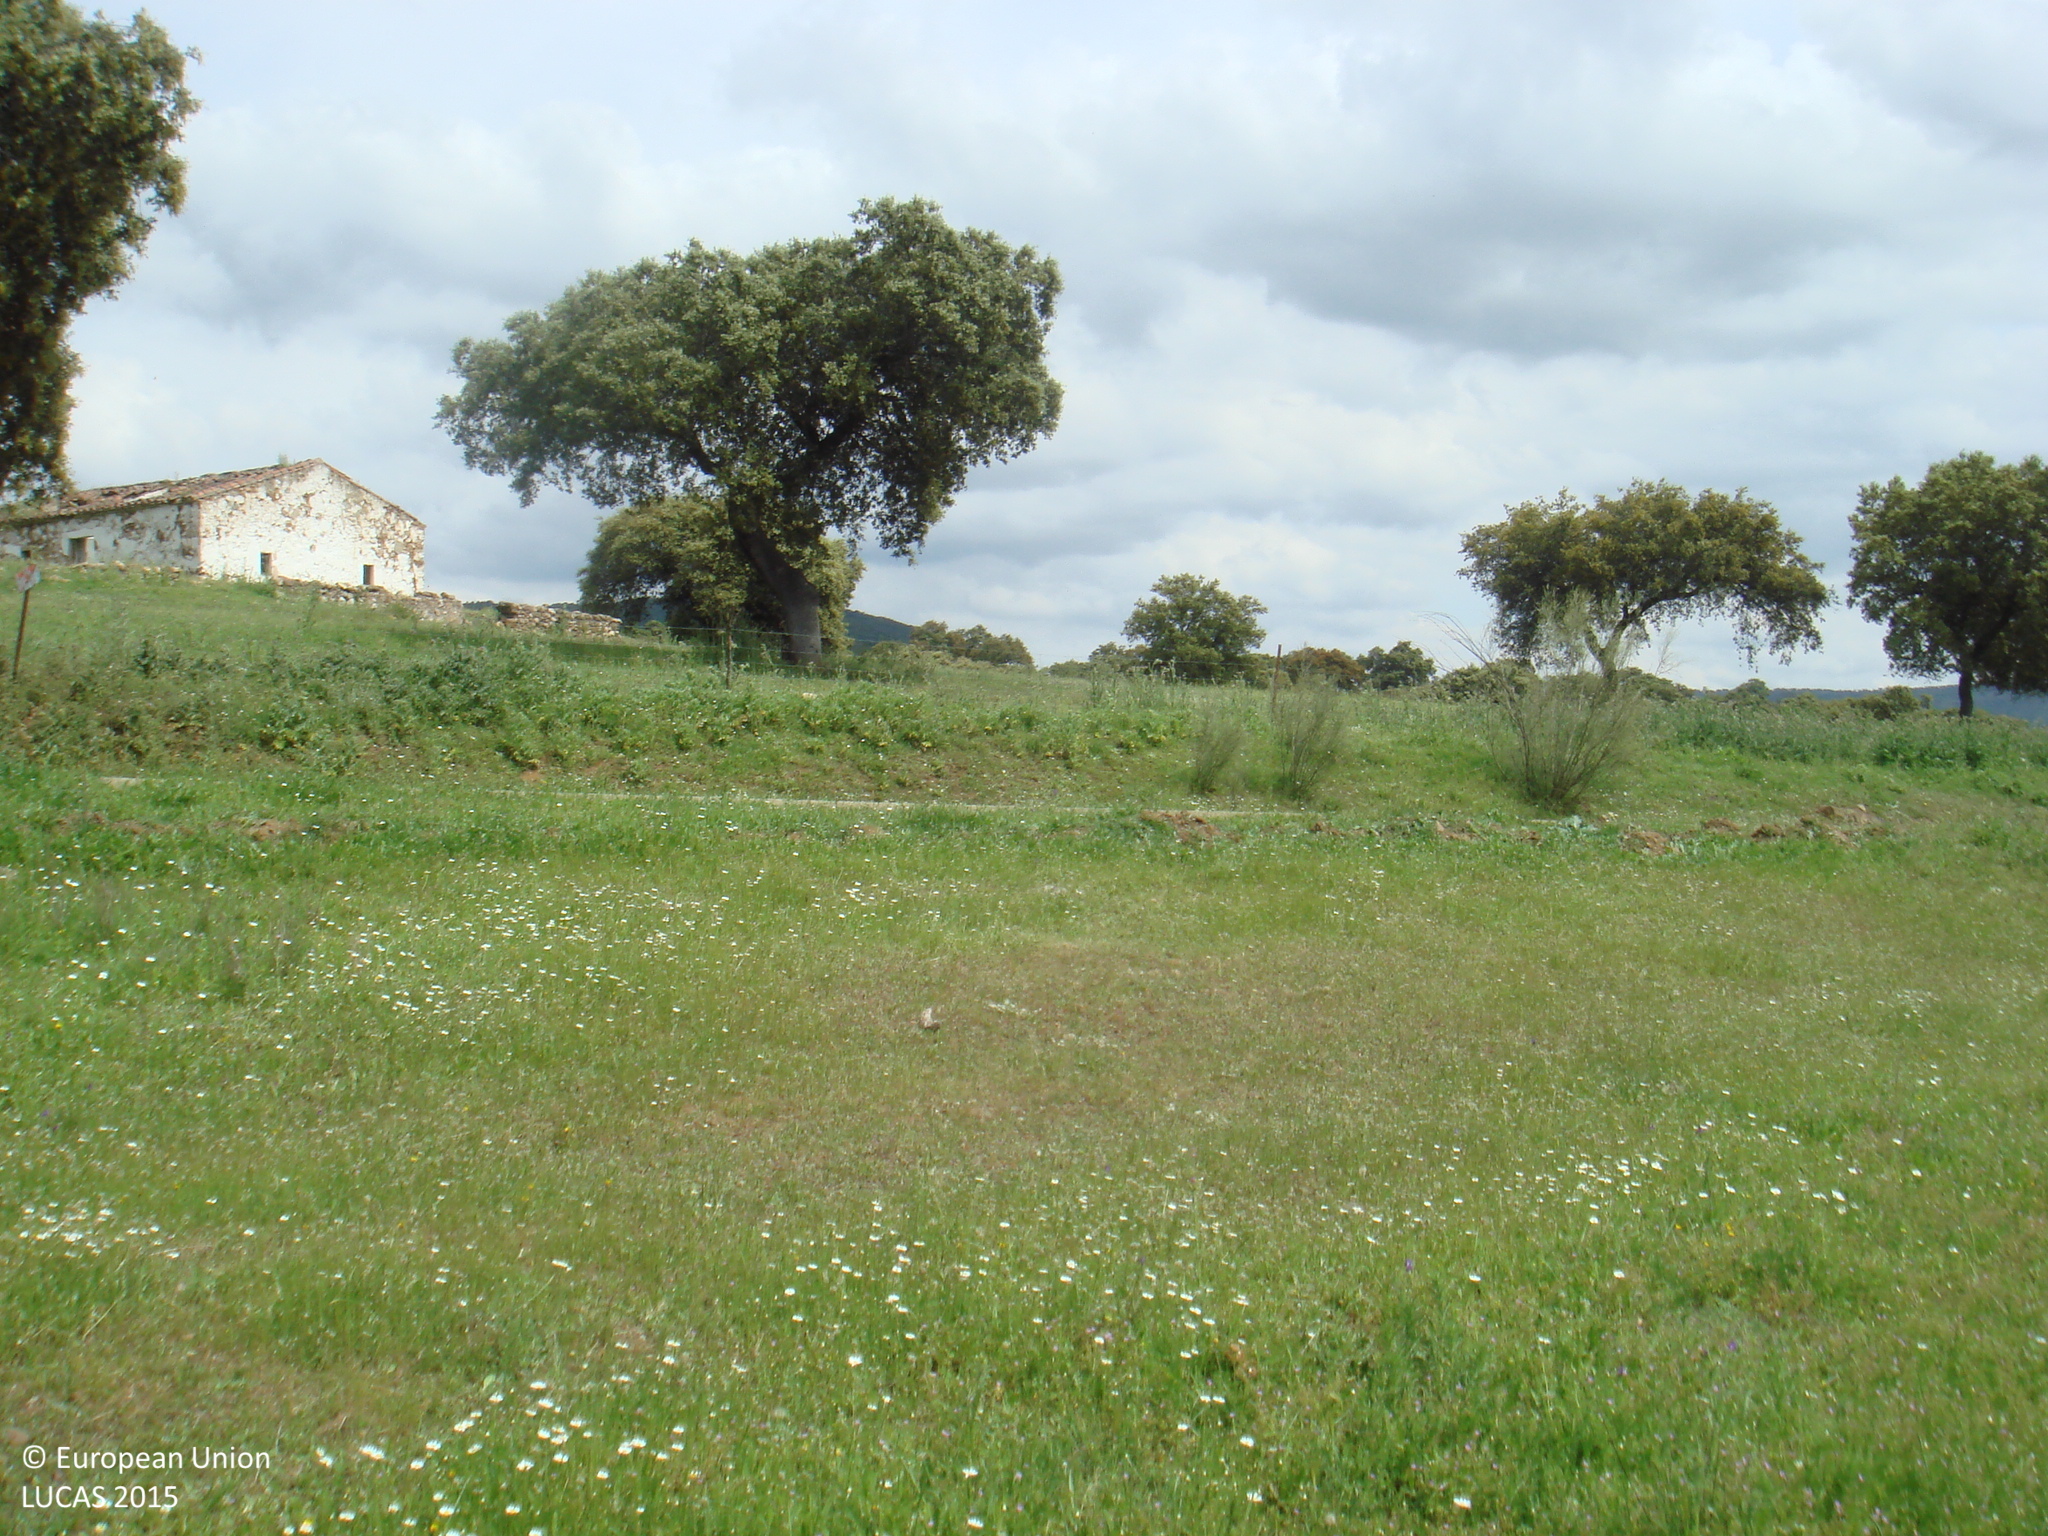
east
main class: Woodland
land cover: Broadleaved woodland
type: broadleaved evergreen forest
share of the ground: 25 - 50 %
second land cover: Grassland without tree/shrub cover
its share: 50 - 75 %
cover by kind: herbaceous plants 55 %, broadleaved forest trees 40 %, shrubs 5 %
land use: Forestry
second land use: Agriculture (excluding fallow land and kitchen gardens)
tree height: > 5 m
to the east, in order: Broadleaved woodland; Grassland without tree/shrub cover; Fences; Grassland with sparse tree/shrub cover; Tracks; Grassland without tree/shrub cover; Fences; Grassland with sparse tree/shrub cover; Rivers and streams; Broadleaved woodland
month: April
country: ES
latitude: 38.2497
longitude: -5.0738
